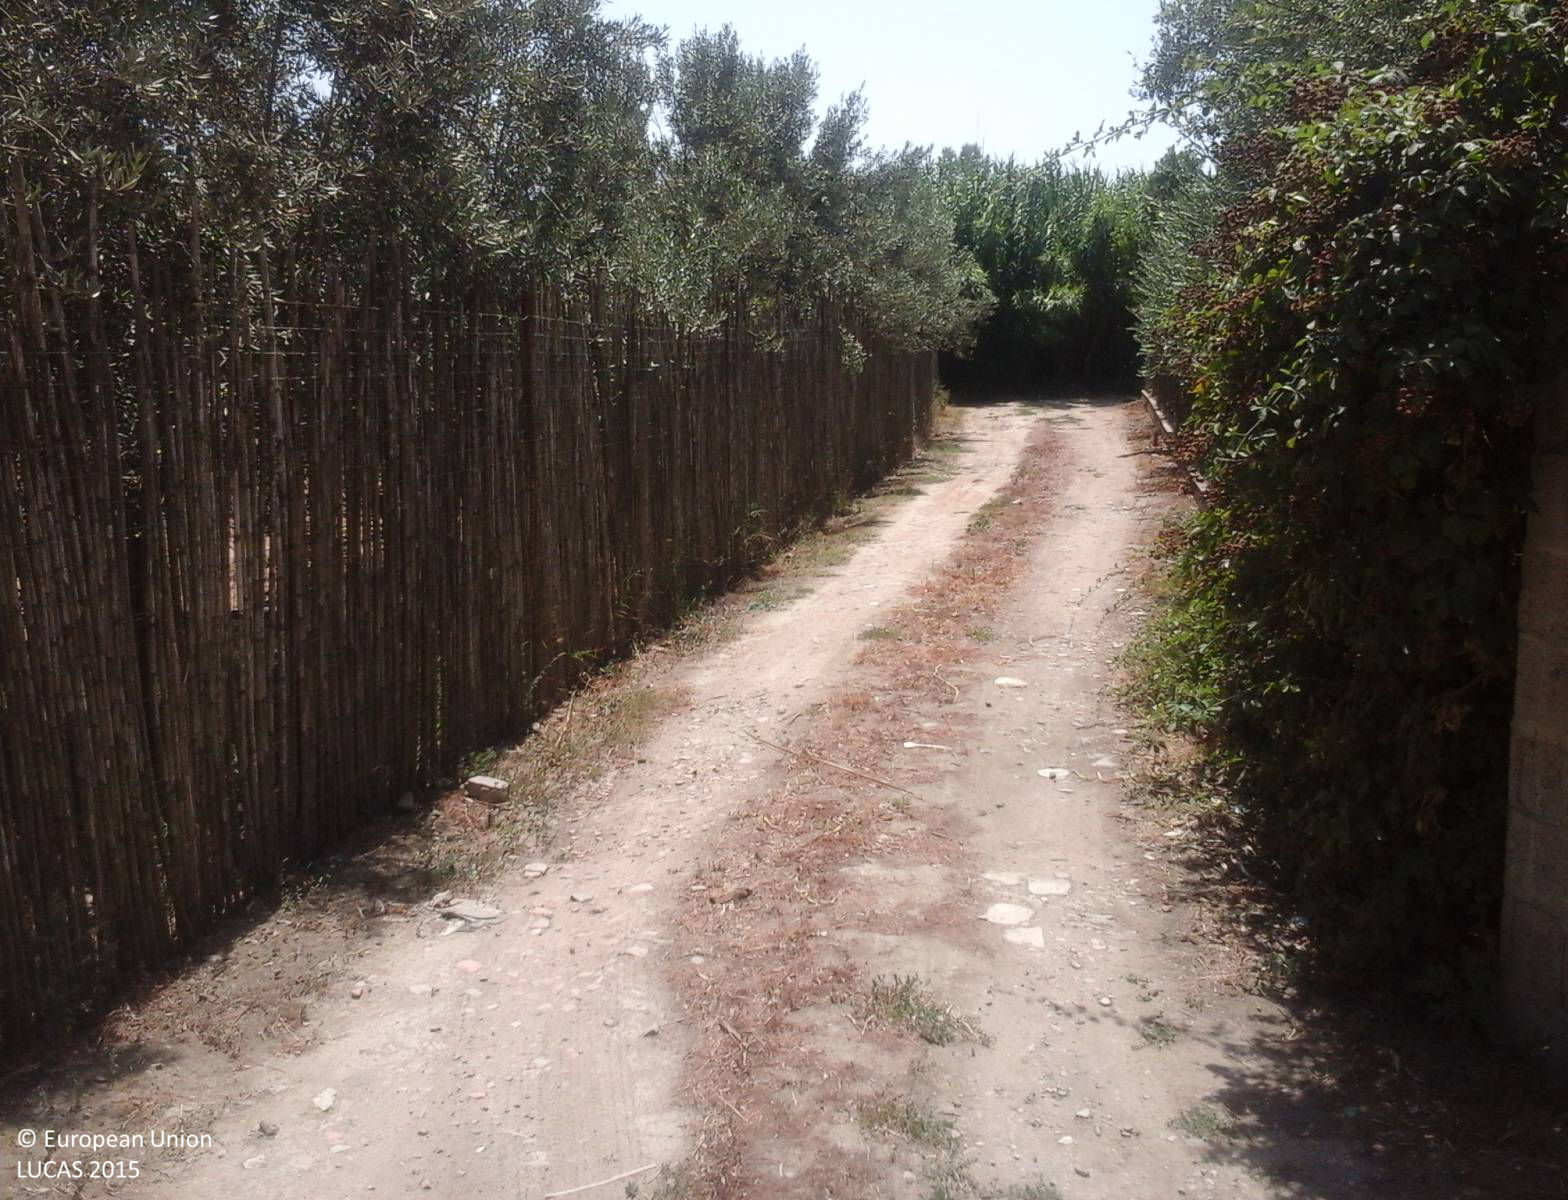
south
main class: Cropland
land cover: Oranges
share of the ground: > 75 %
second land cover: Grassland without tree/shrub cover
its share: > 75 %
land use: Agriculture (excluding fallow land and kitchen gardens)
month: August
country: IT
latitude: 39.4281
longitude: 8.9030
